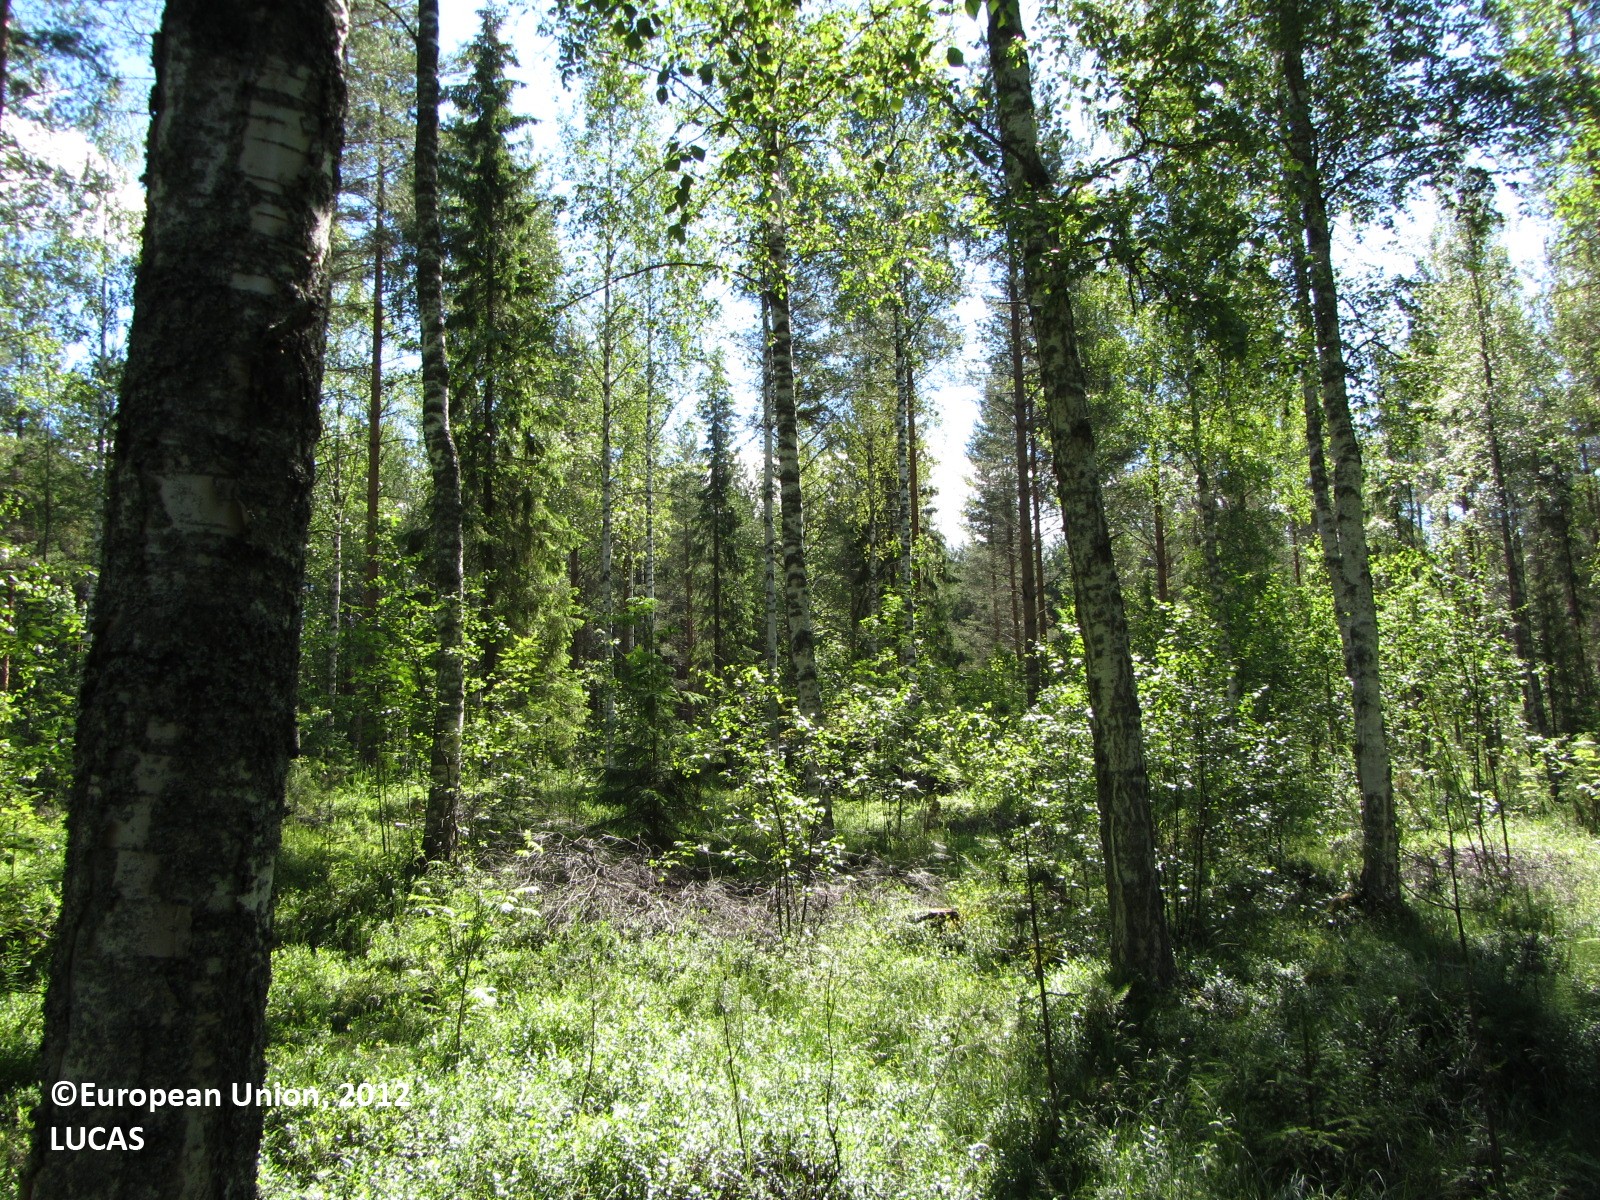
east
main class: Woodland
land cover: Other mixed woodland
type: boreal forest
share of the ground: > 75 %
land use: Forestry
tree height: > 5 m
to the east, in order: Other mixed woodland; Tracks; Other mixed woodland; Ditches and canals; Paved roads, cycling and walking lanes; Grass margins; Ditches and canals; Abandoned hedges; Pine dominated mixed woodland; Grassland without tree/shrub cover; Pine dominated mixed woodland; Spruce dominated coniferous woodland; Other mixed woodland; Spruce dominated coniferous woodland
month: July
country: FI
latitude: 63.1004
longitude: 25.2560
